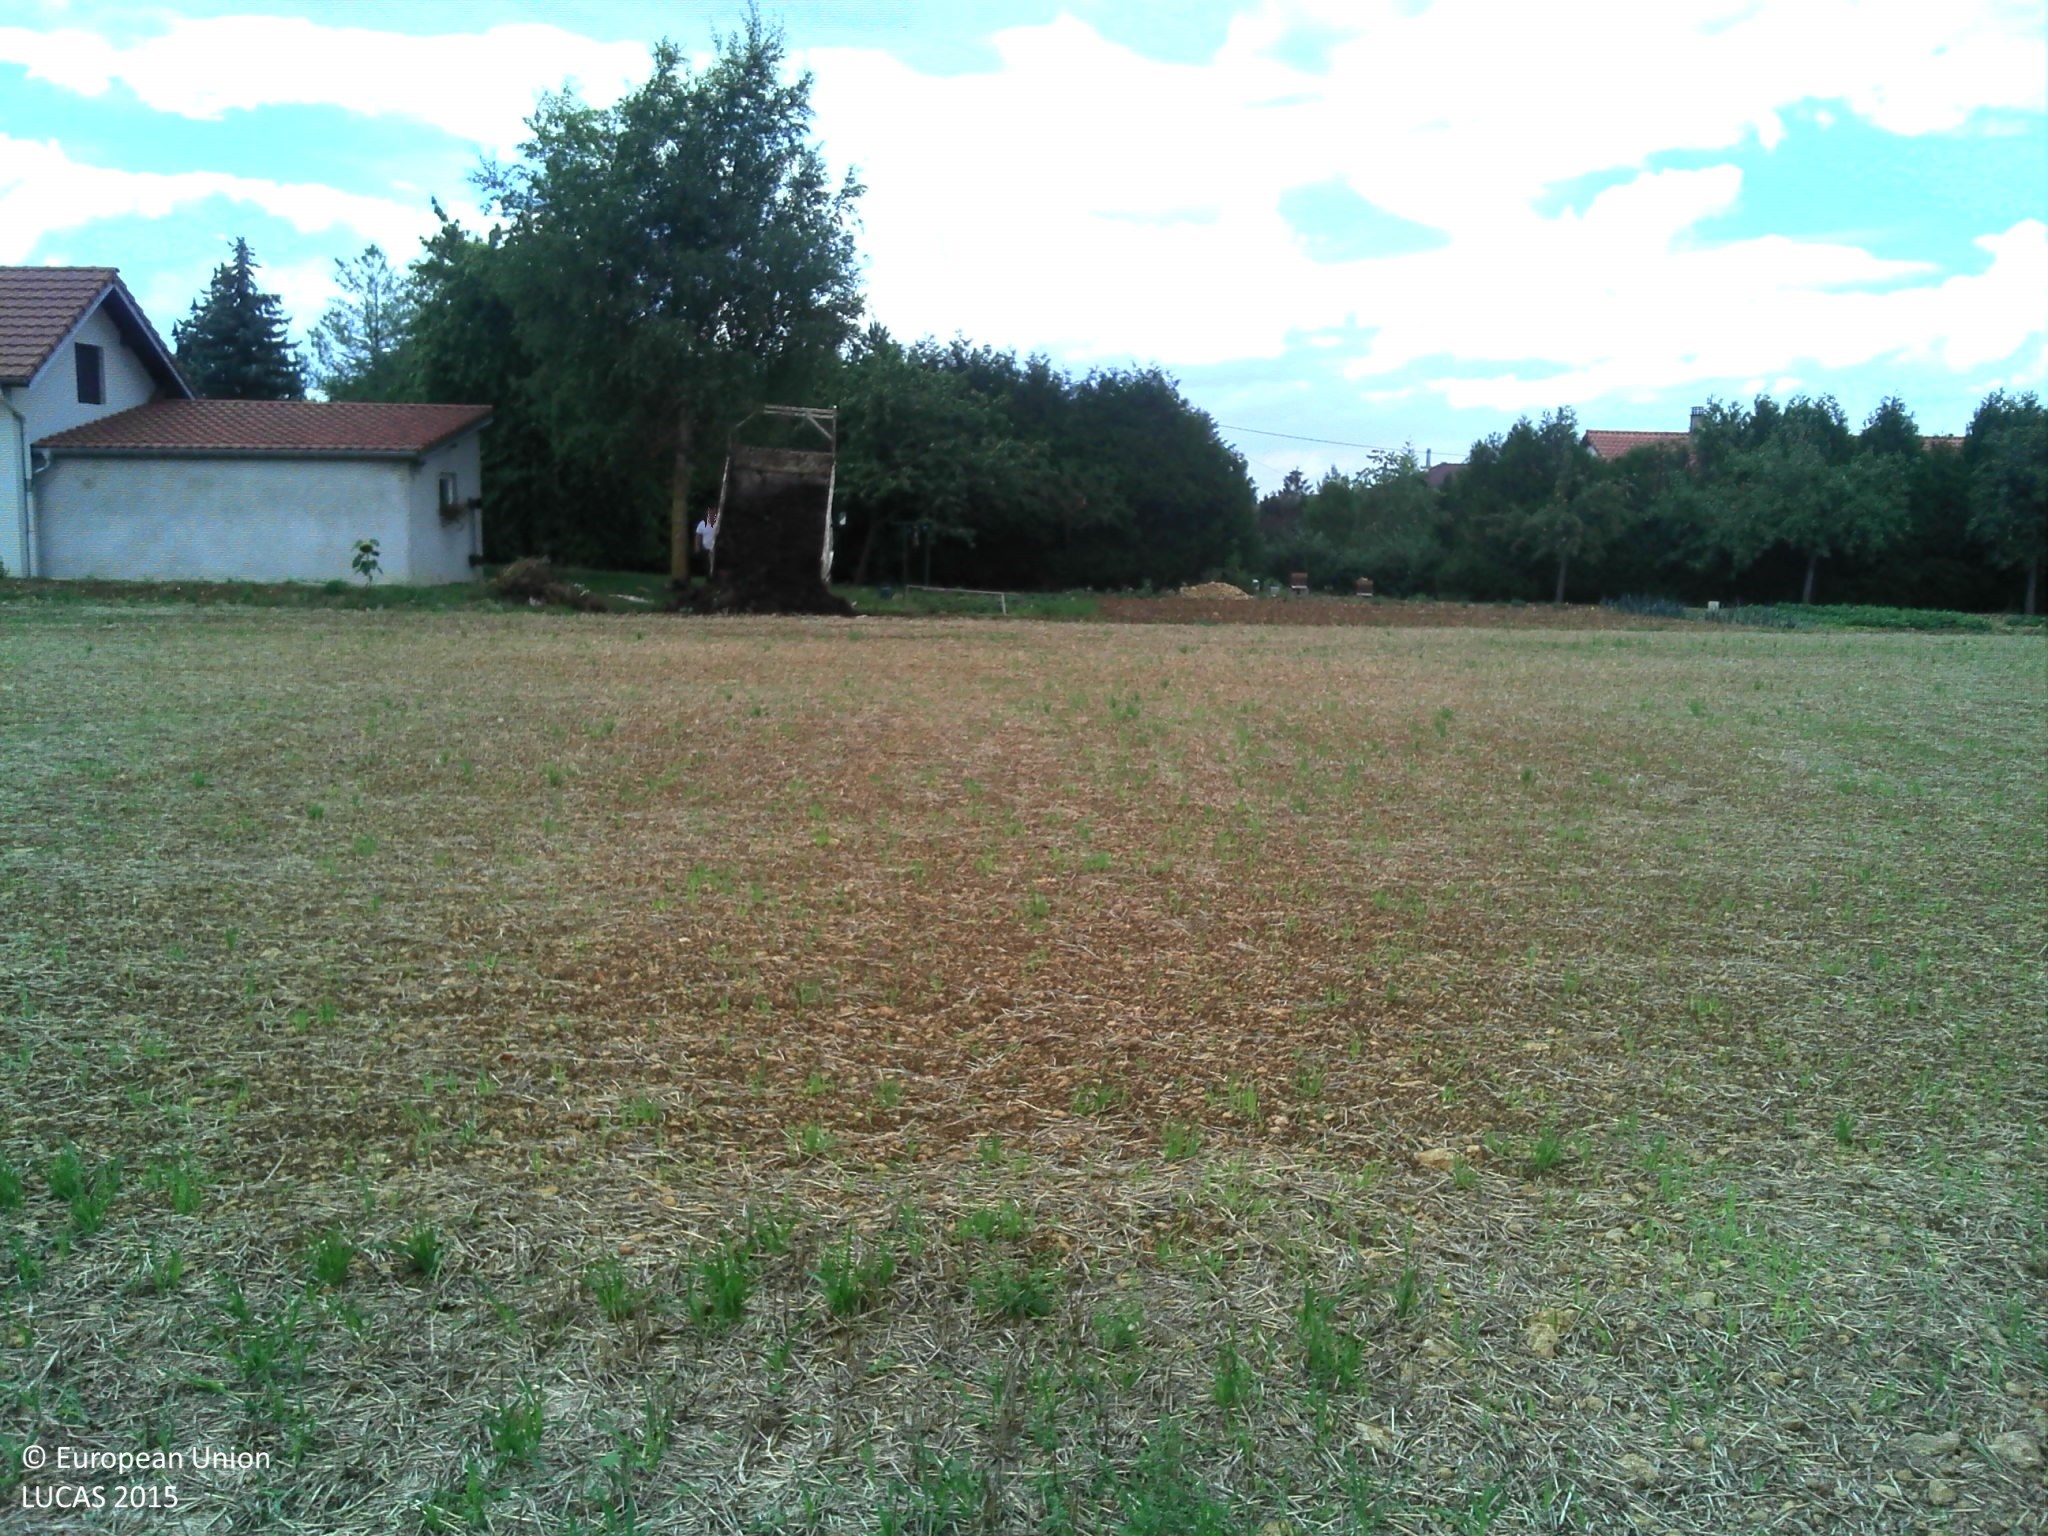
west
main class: Cropland
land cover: Common wheat
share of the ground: > 75 %
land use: Agriculture (excluding fallow land and kitchen gardens)
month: September
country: FR
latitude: 49.1222
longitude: 5.9572
